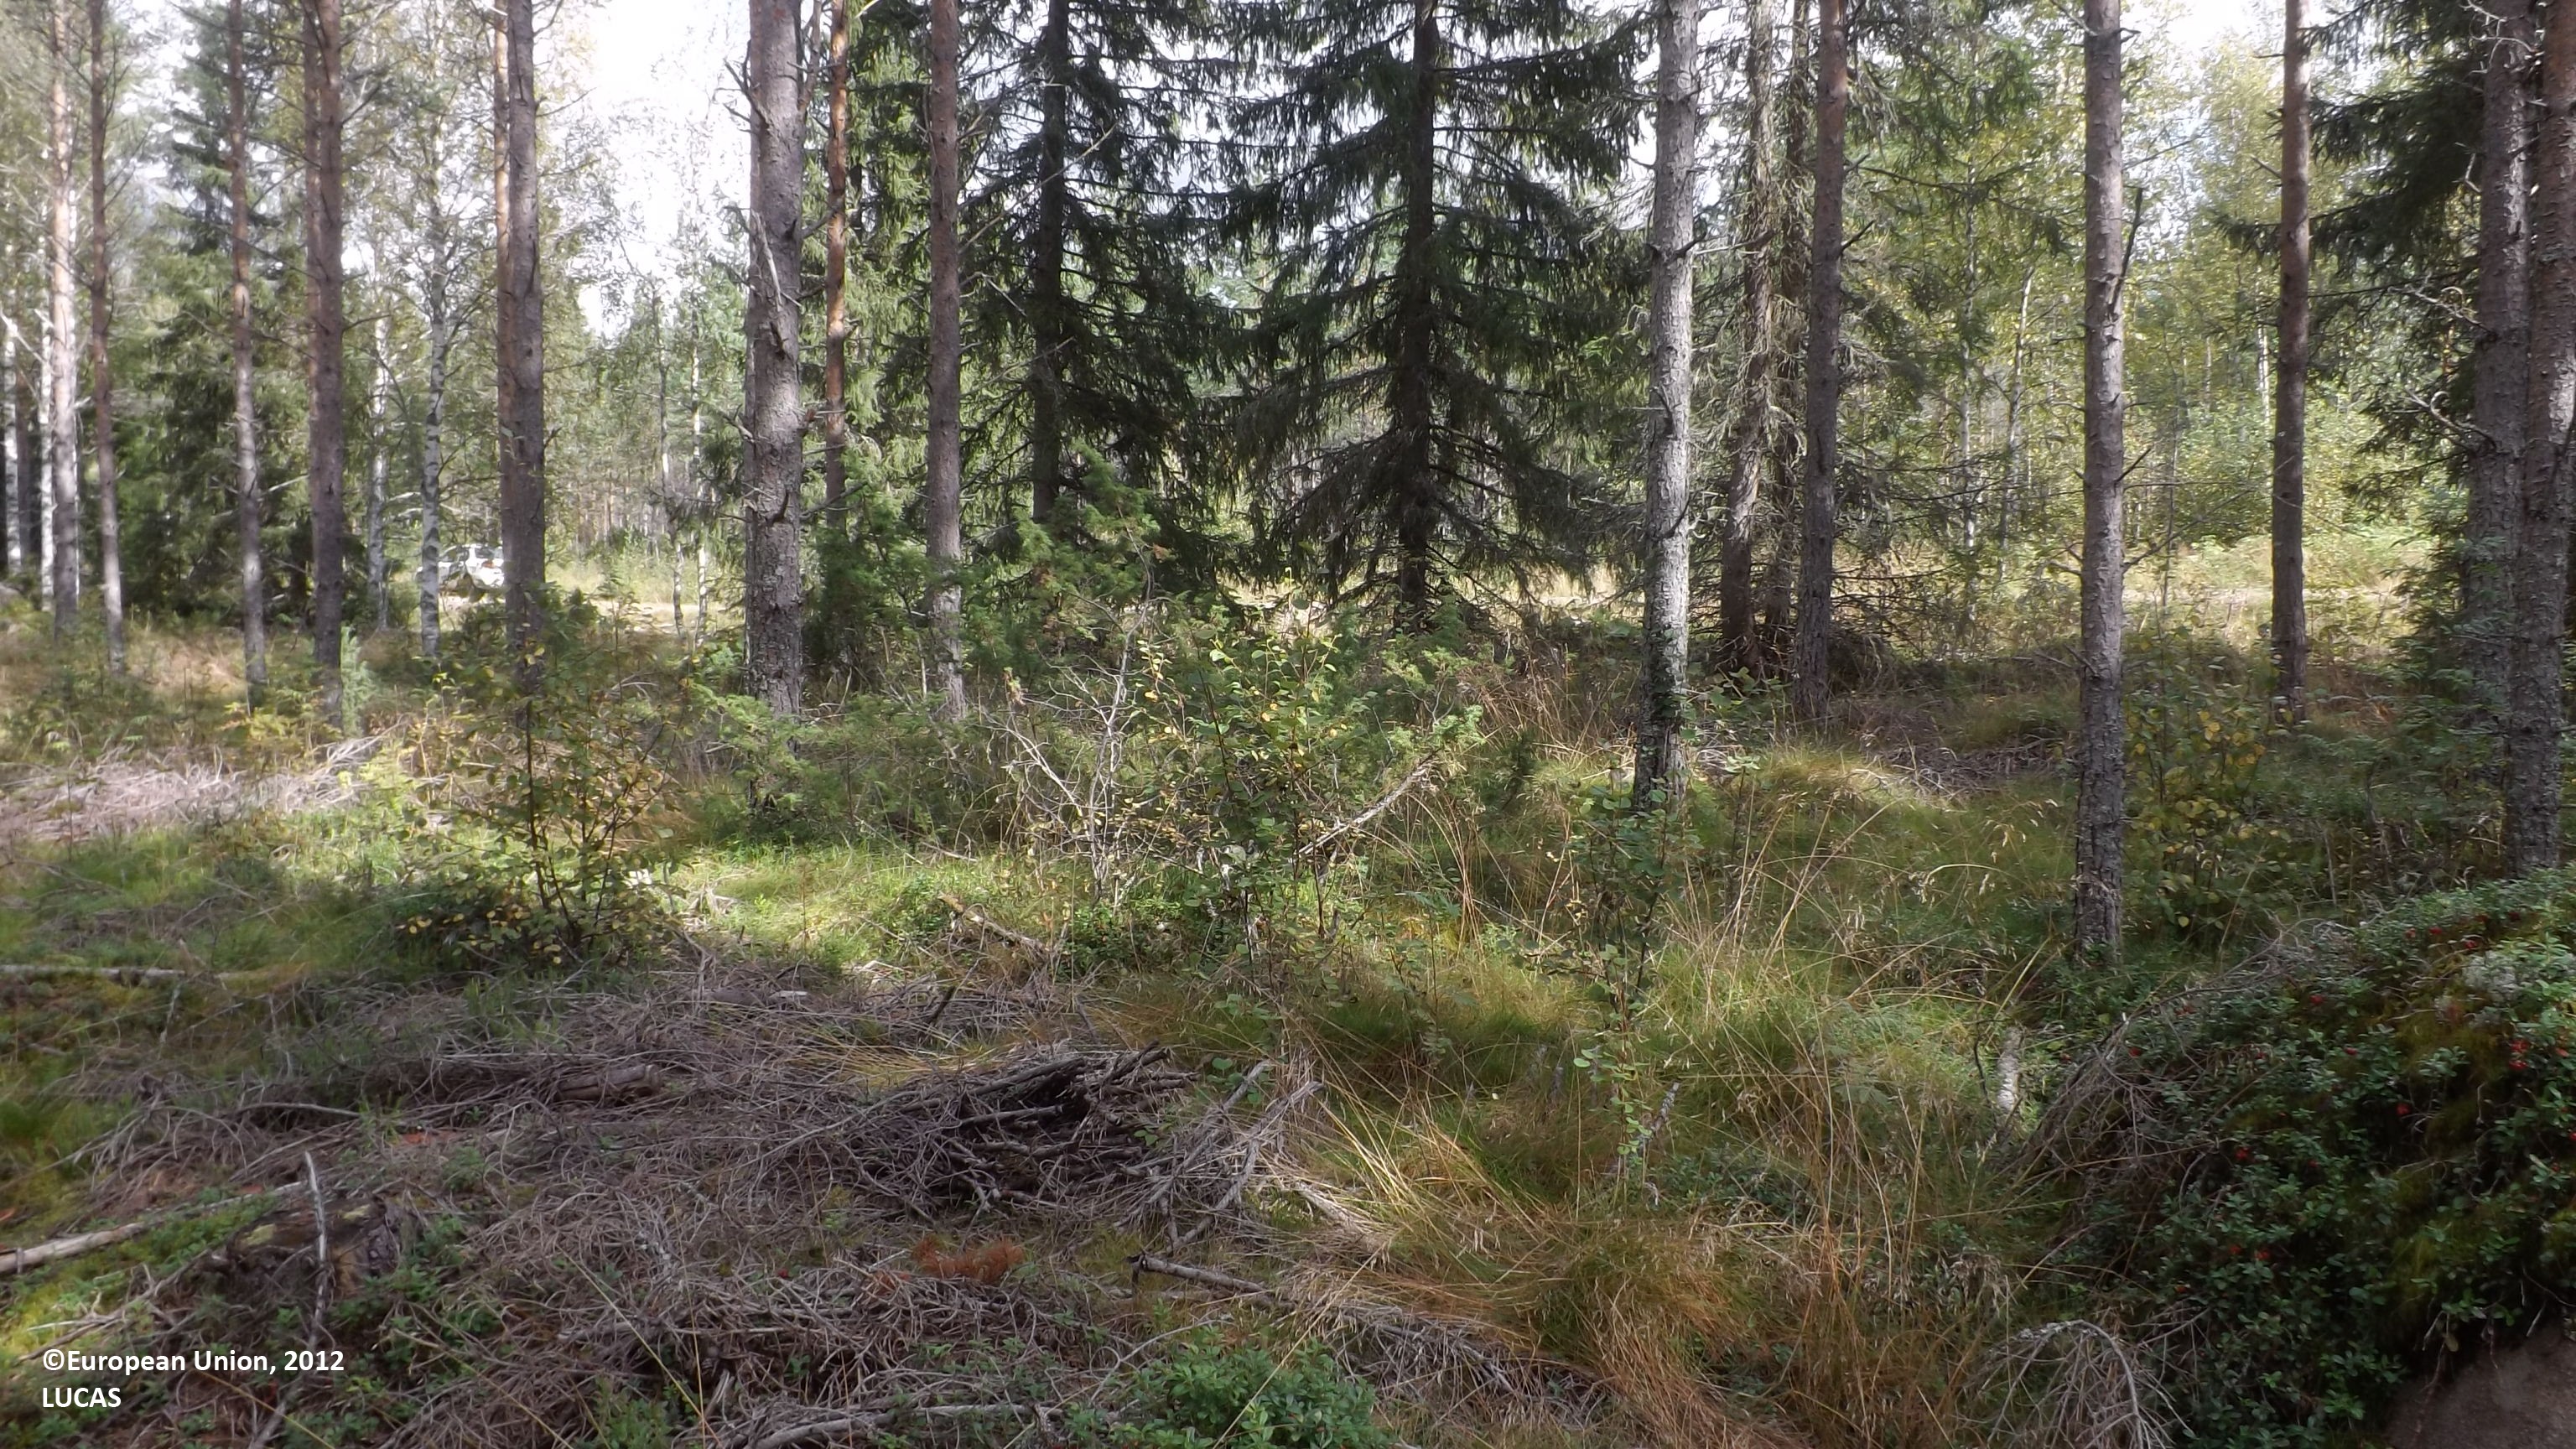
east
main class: Woodland
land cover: Pine dominated mixed woodland
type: boreal forest
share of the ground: 50 - 75 %
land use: Forestry
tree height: > 5 m
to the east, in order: Pine dominated mixed woodland; Paved roads, cycling and walking lanes; Shrubland with sparse tree cover; Ditches and canals; Pine dominated mixed woodland; Other mixed woodland; Pine dominated mixed woodland; Ditches and canals; Pine dominated mixed woodland; Pine dominated coniferous woodland; Ditches and canals; Pine dominated coniferous woodland; Pine dominated mixed woodland
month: August
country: FI
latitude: 63.7099
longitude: 23.4762
